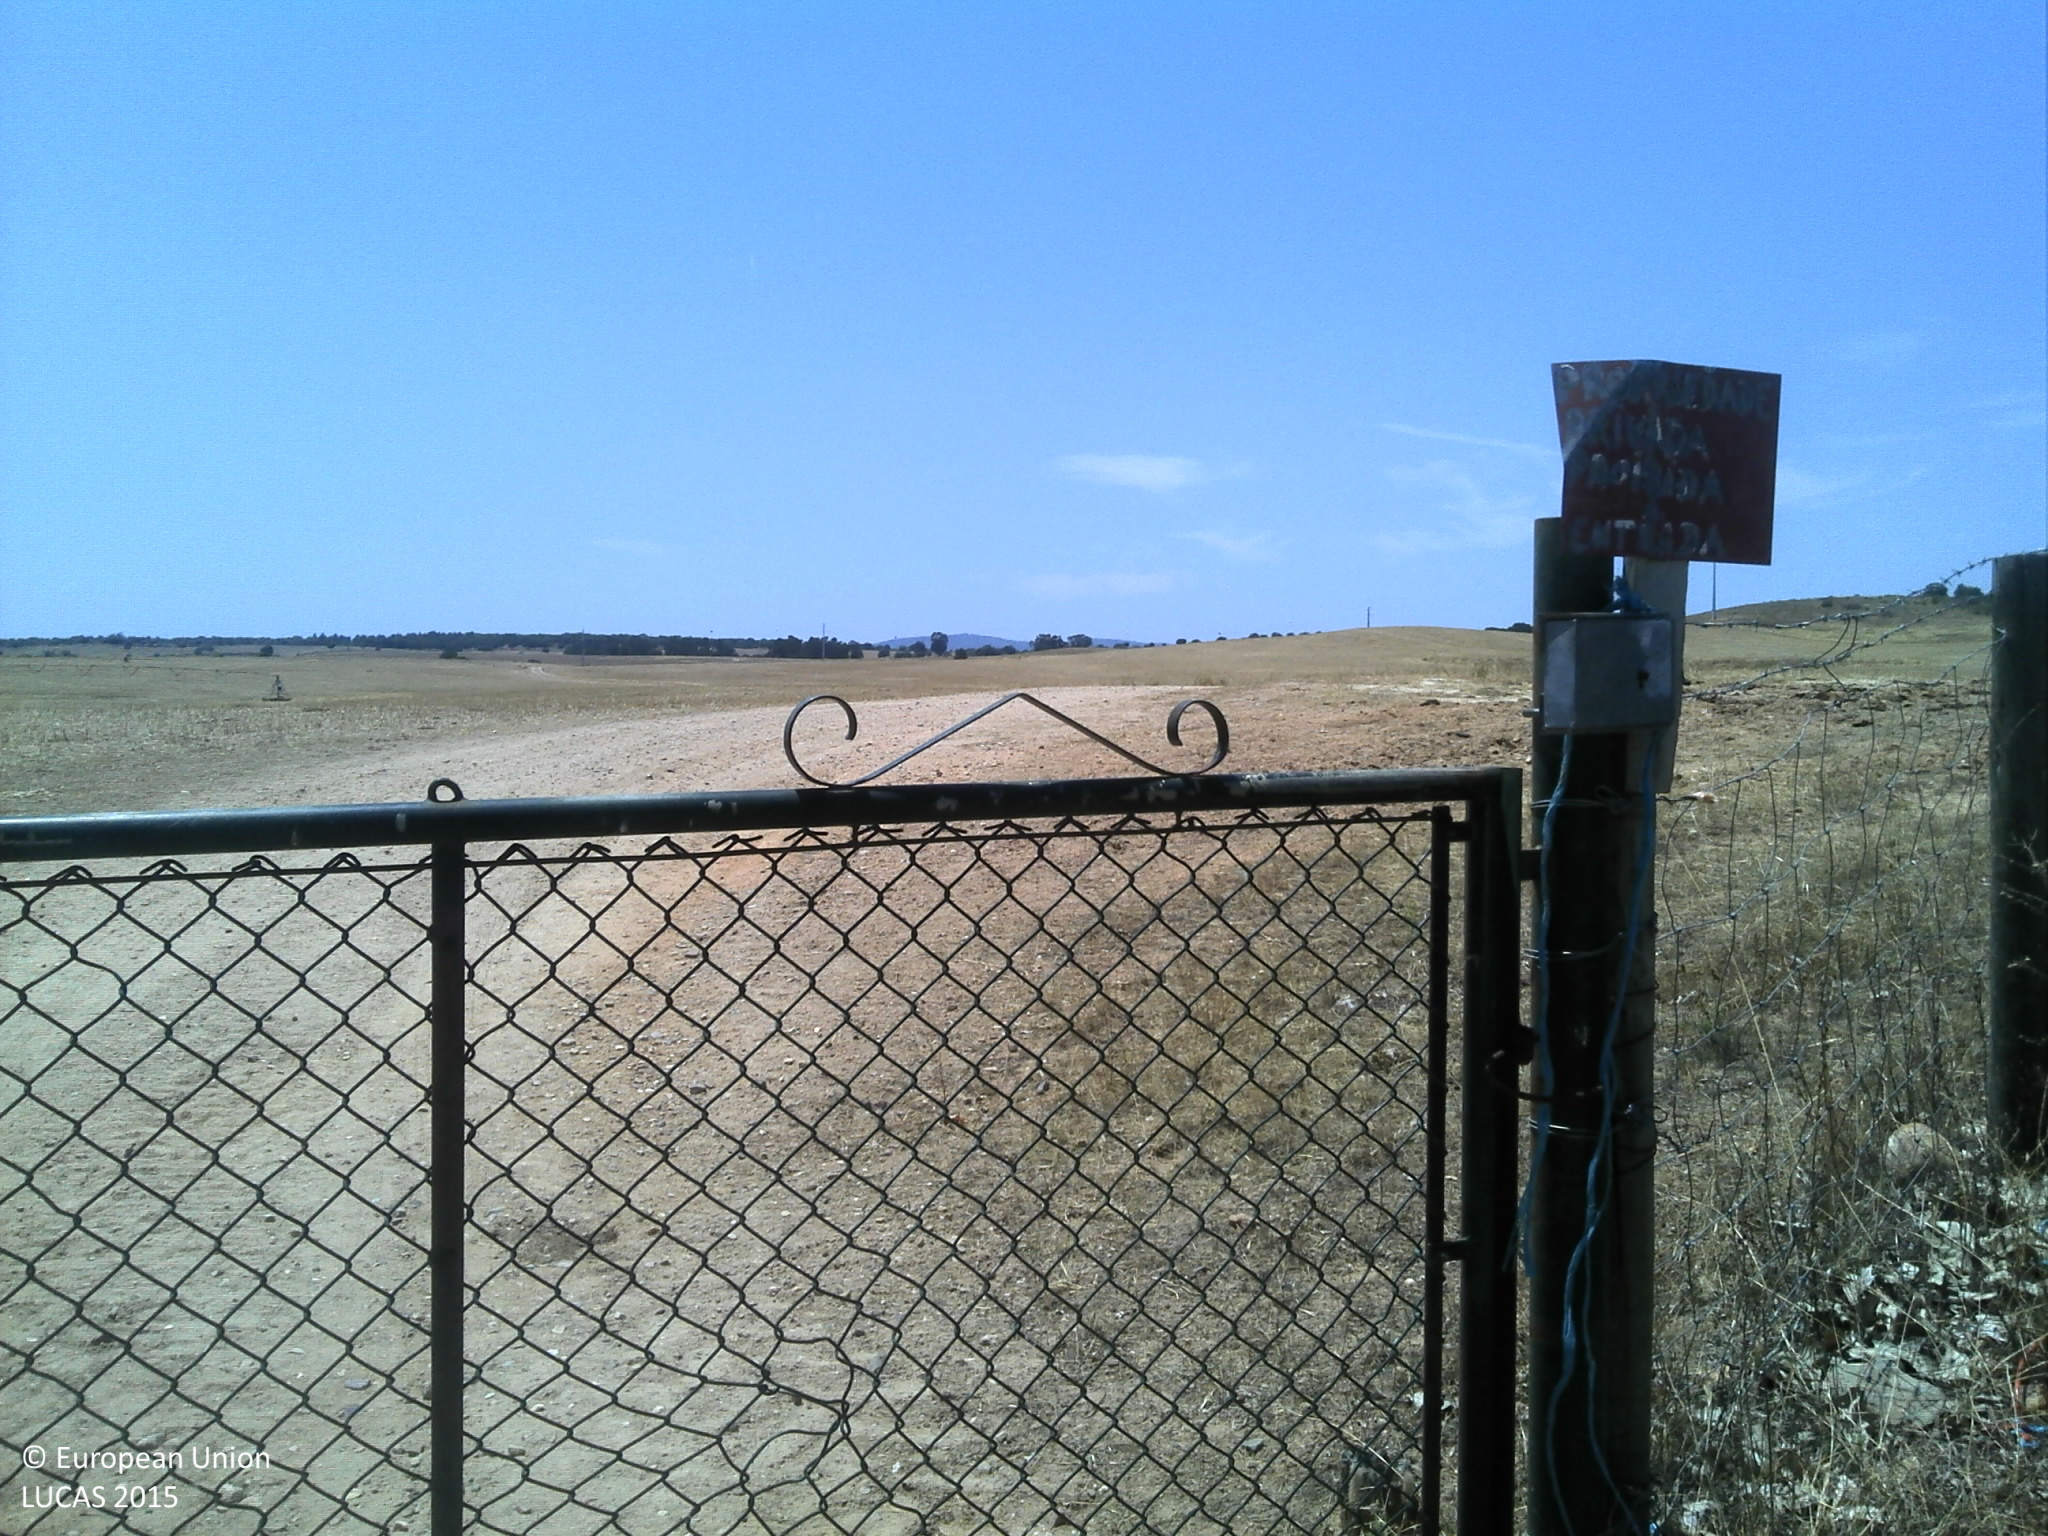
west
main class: Cropland
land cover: Arable land (only in case pi)
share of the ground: 50 - 75 %
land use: Agriculture (excluding fallow land and kitchen gardens)
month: June
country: PT
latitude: 39.8265
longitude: -7.1851
